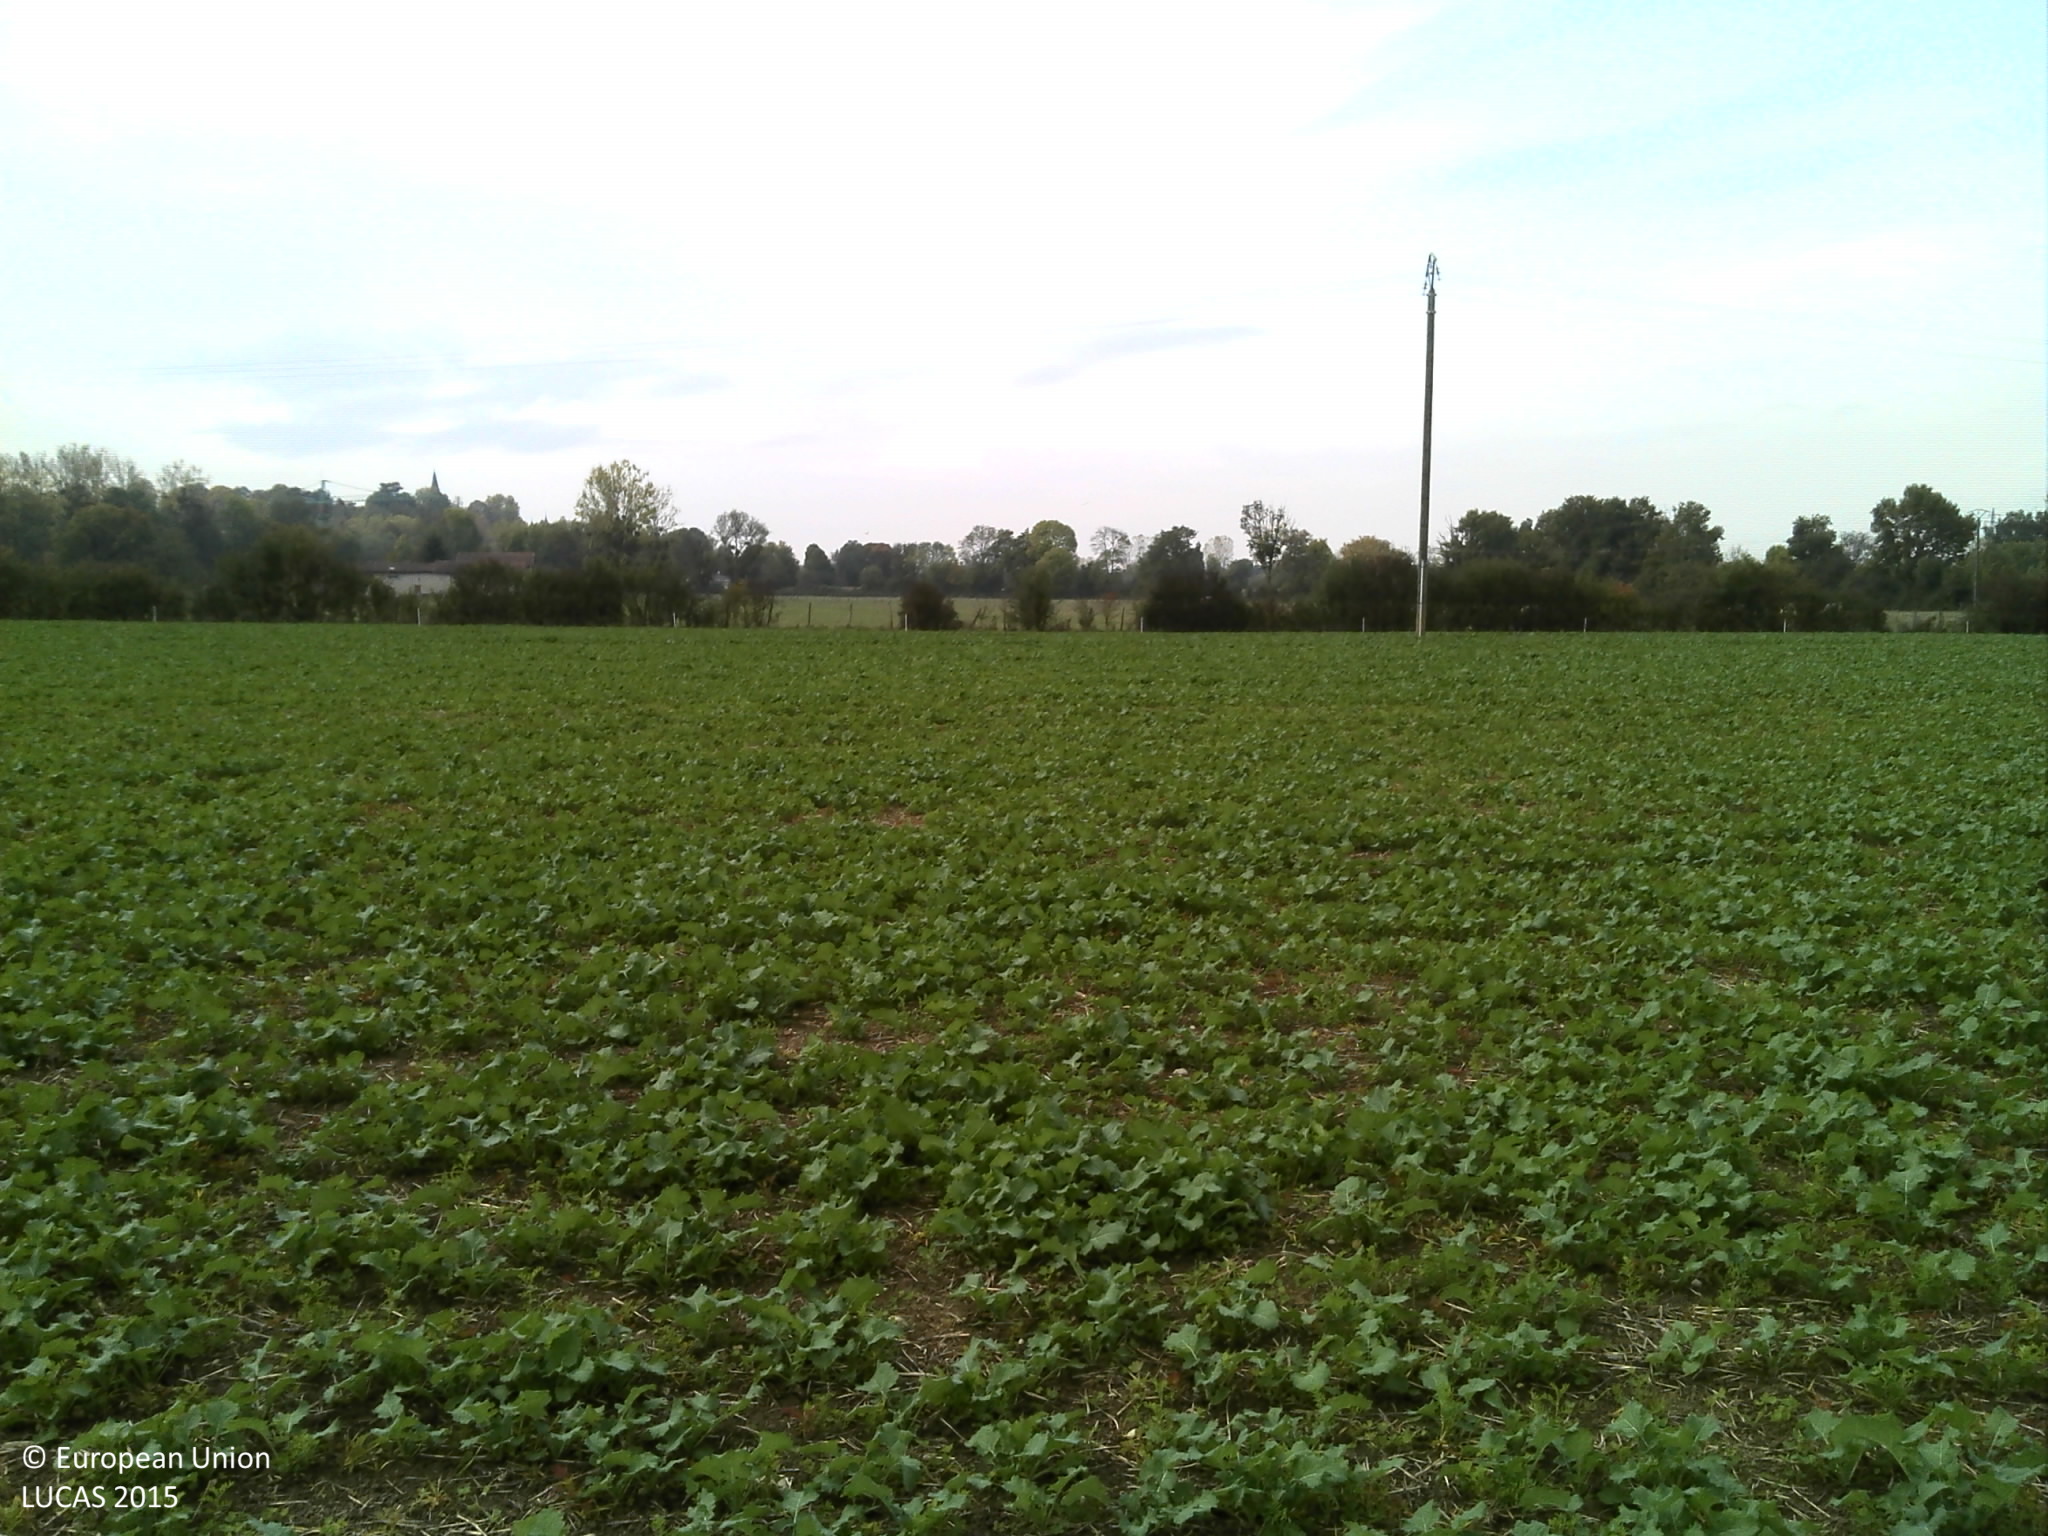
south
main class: Cropland
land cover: Rape and turnip rape
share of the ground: 50 - 75 %
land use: Agriculture (excluding fallow land and kitchen gardens)
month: October
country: FR
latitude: 46.0163
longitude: 5.3666
